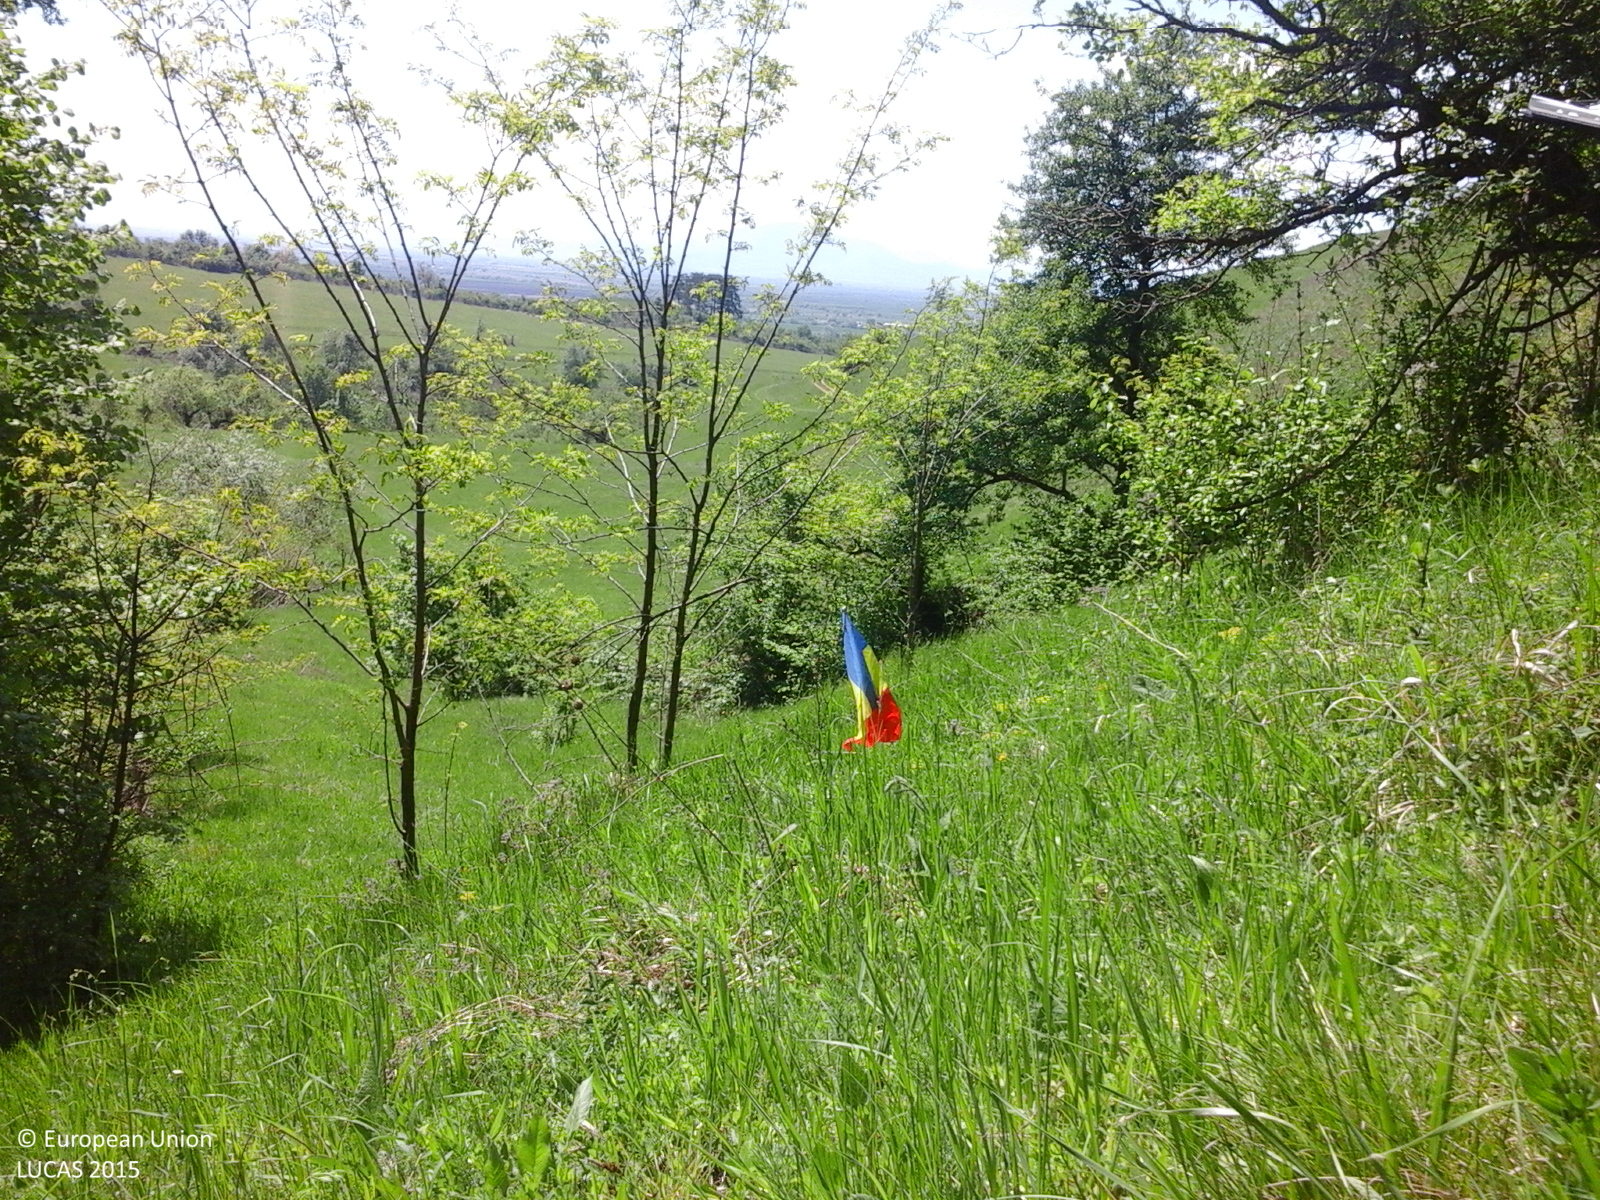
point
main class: Grassland
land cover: Grassland with sparse tree/shrub cover
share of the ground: > 75 %
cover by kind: herbaceous plants 85 %, shrubs 10 %, broadleaved forest trees 5 %
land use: Forestry
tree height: > 5 m
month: May
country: RO
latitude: 45.8112
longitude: 25.6657
